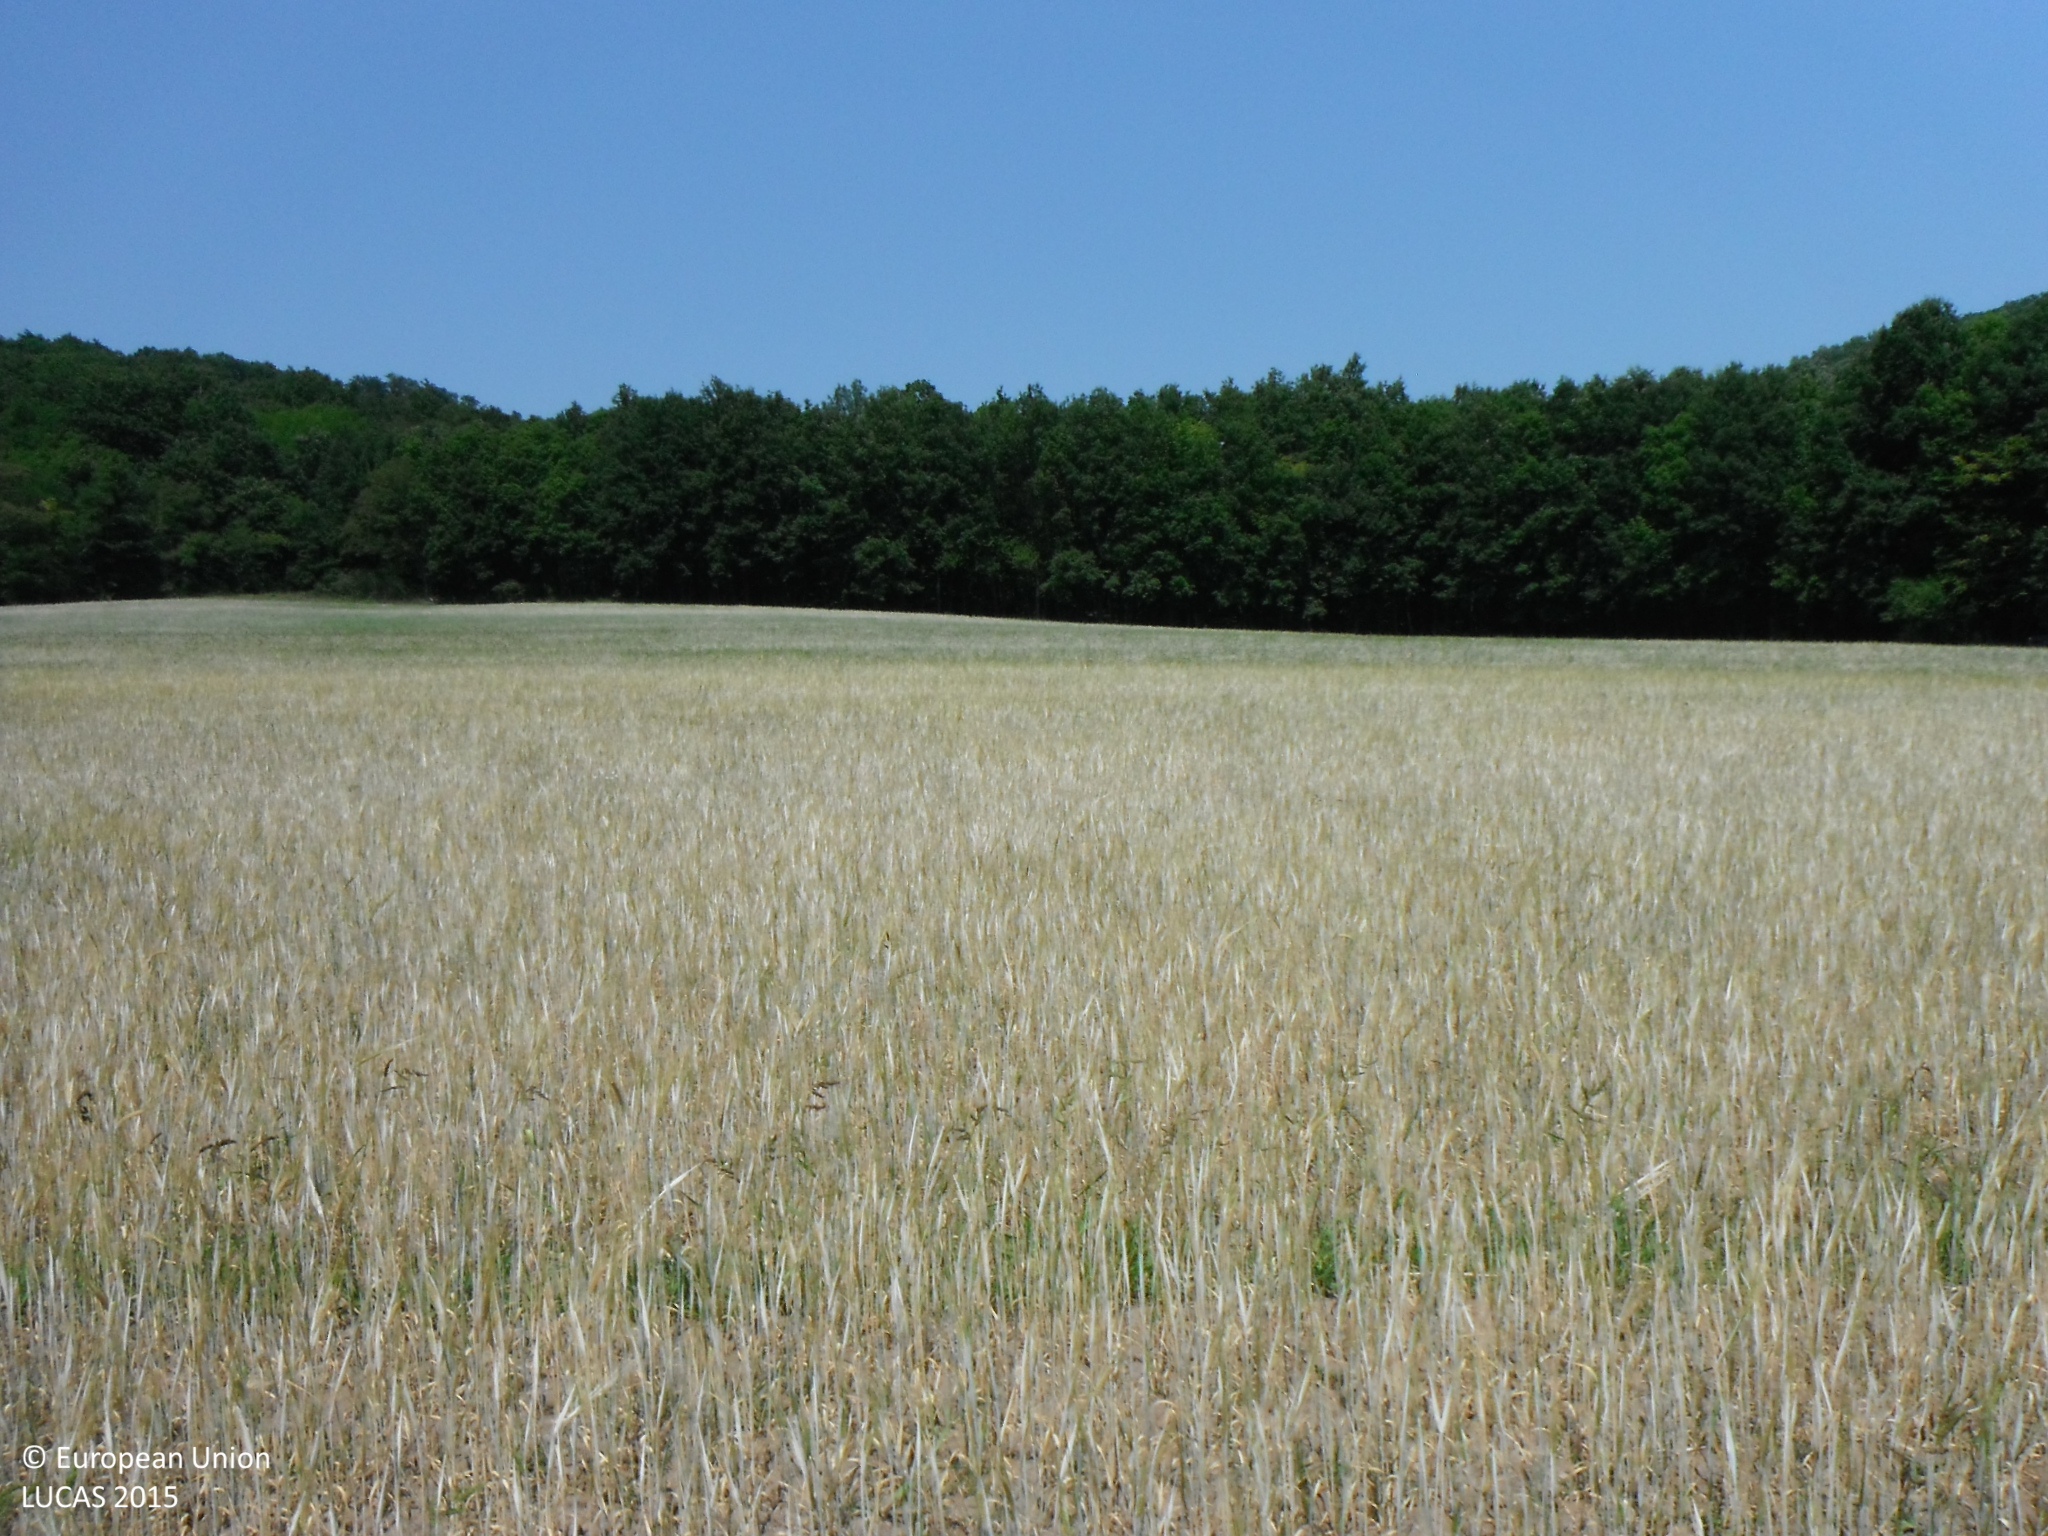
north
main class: Cropland
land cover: Barley
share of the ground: > 75 %
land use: Agriculture (excluding fallow land and kitchen gardens)
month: July
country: SK
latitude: 48.1861
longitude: 19.1542
